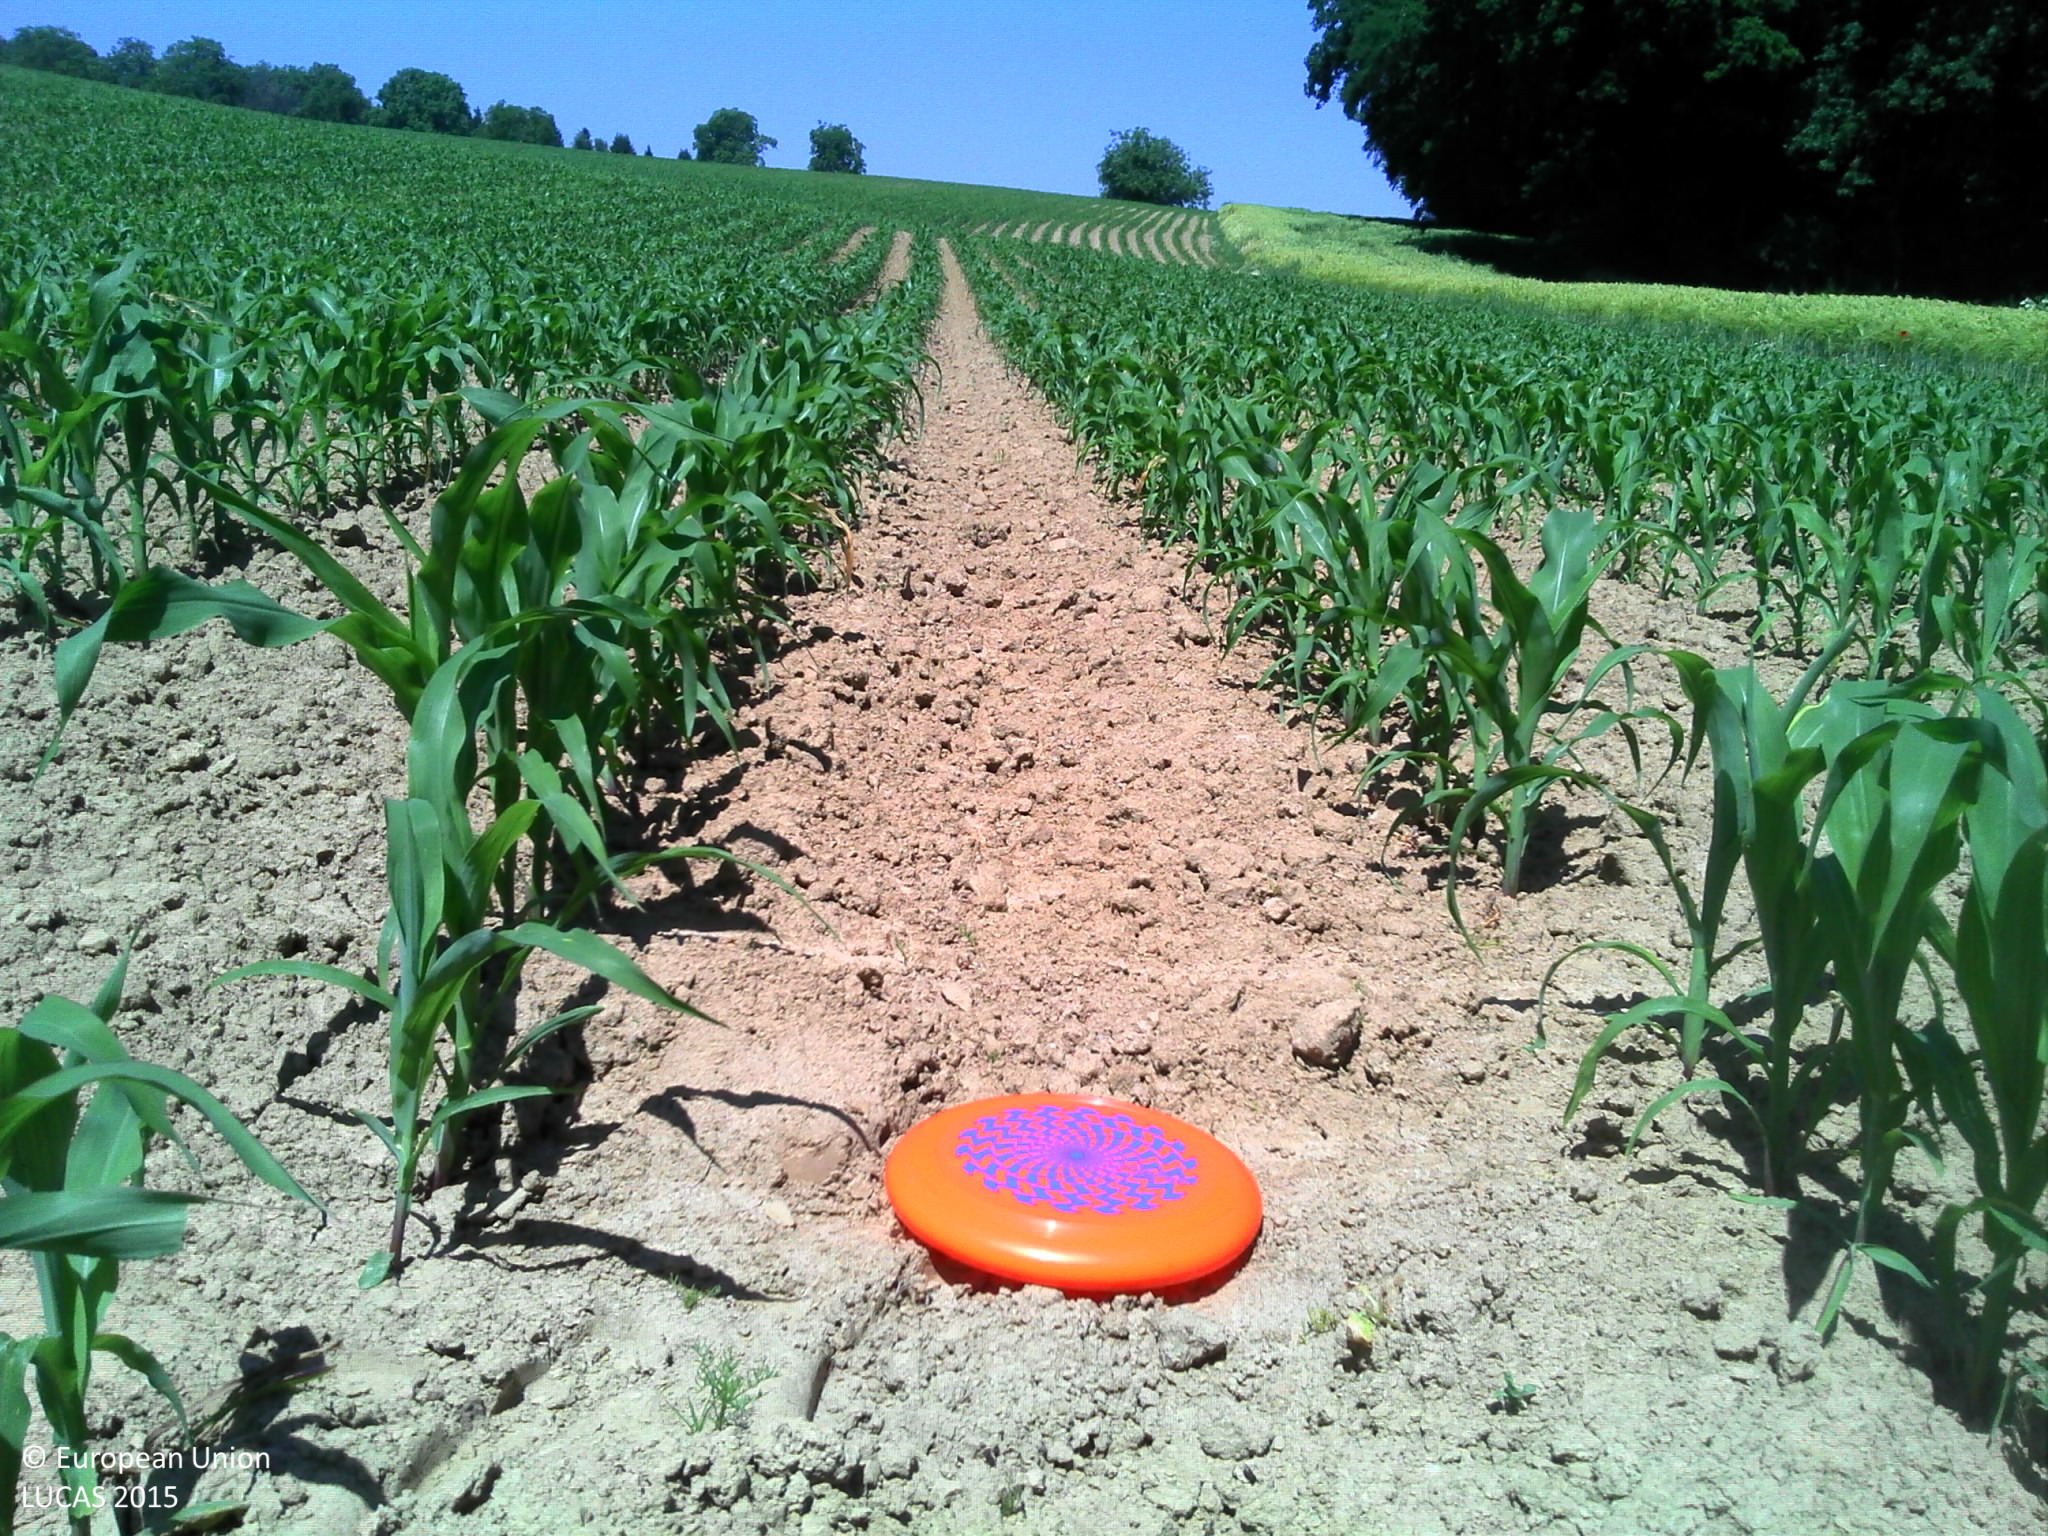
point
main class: Cropland
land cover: Maize
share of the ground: 10 - 25 %
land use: Agriculture (excluding fallow land and kitchen gardens)
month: June
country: FR
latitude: 47.5648
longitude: 7.4895
